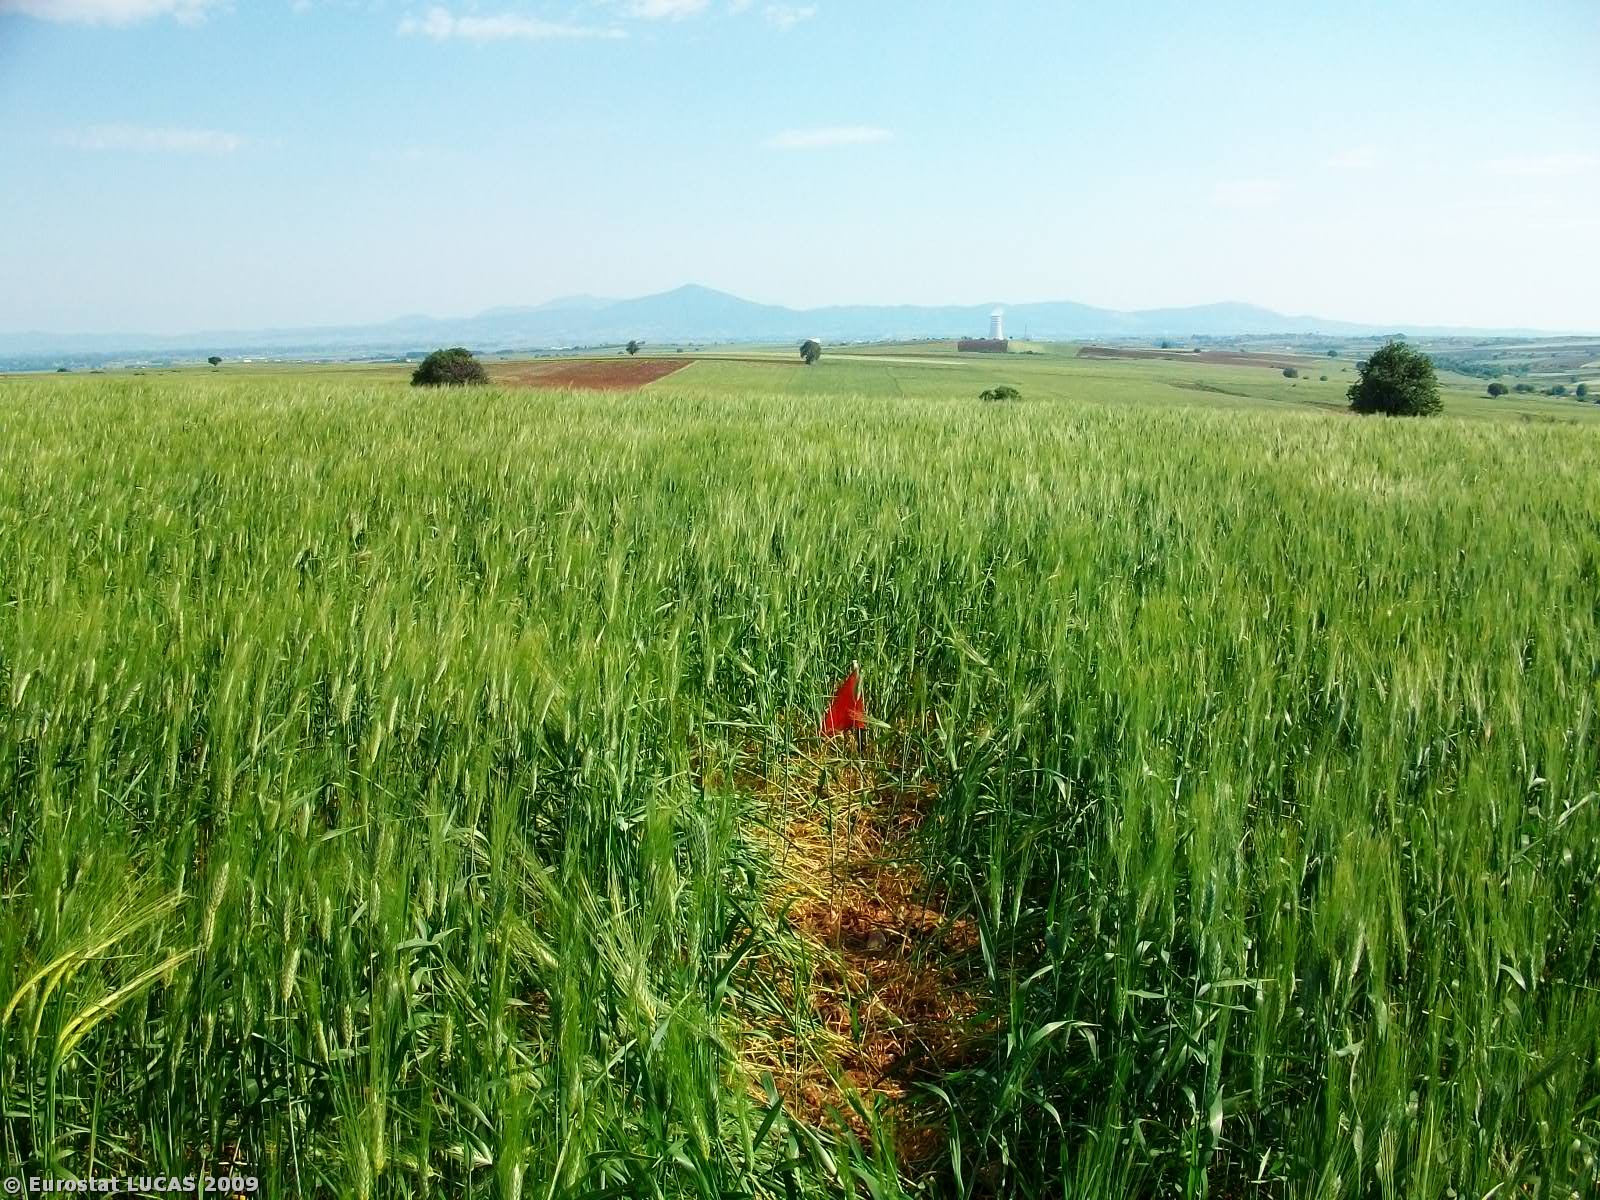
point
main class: Cropland
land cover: Durum wheat
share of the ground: > 75 %
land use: Agriculture (excluding fallow land and kitchen gardens)
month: May
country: GR
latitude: 41.1219
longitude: 25.5003
